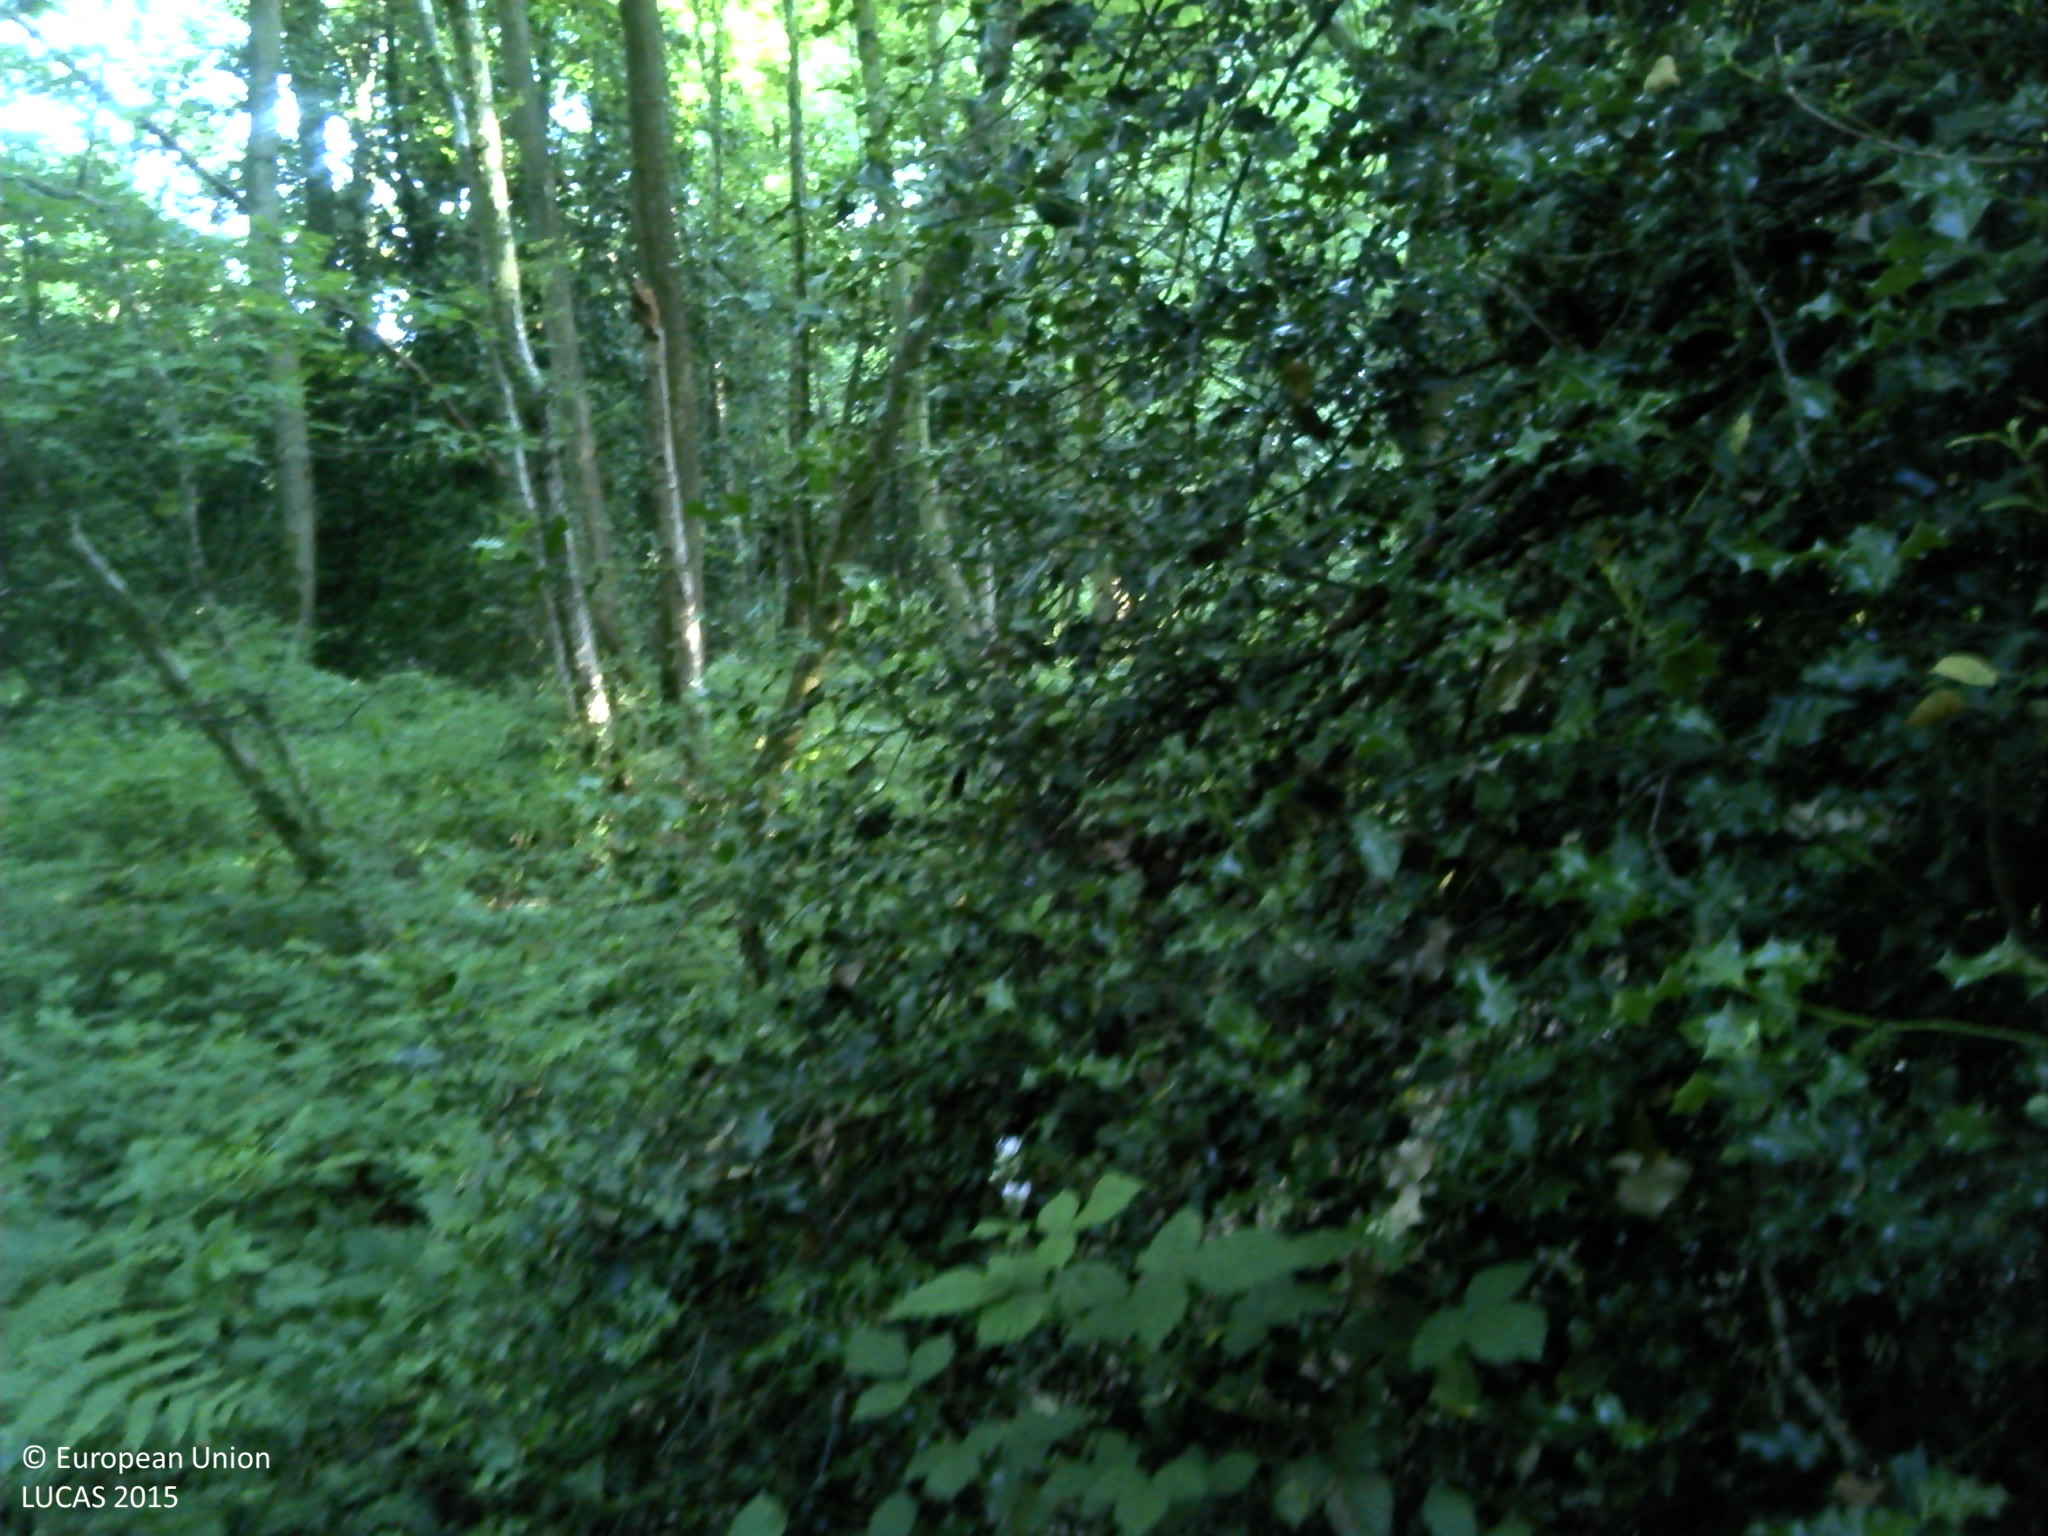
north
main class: Woodland
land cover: Broadleaved woodland
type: acidophilous oak and oak-birch forest
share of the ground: > 75 %
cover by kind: broadleaved forest trees 100 %
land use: Forestry
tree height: > 5 m
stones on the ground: 25 - 50 %
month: July
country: FR
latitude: 49.3579
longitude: 1.2370
